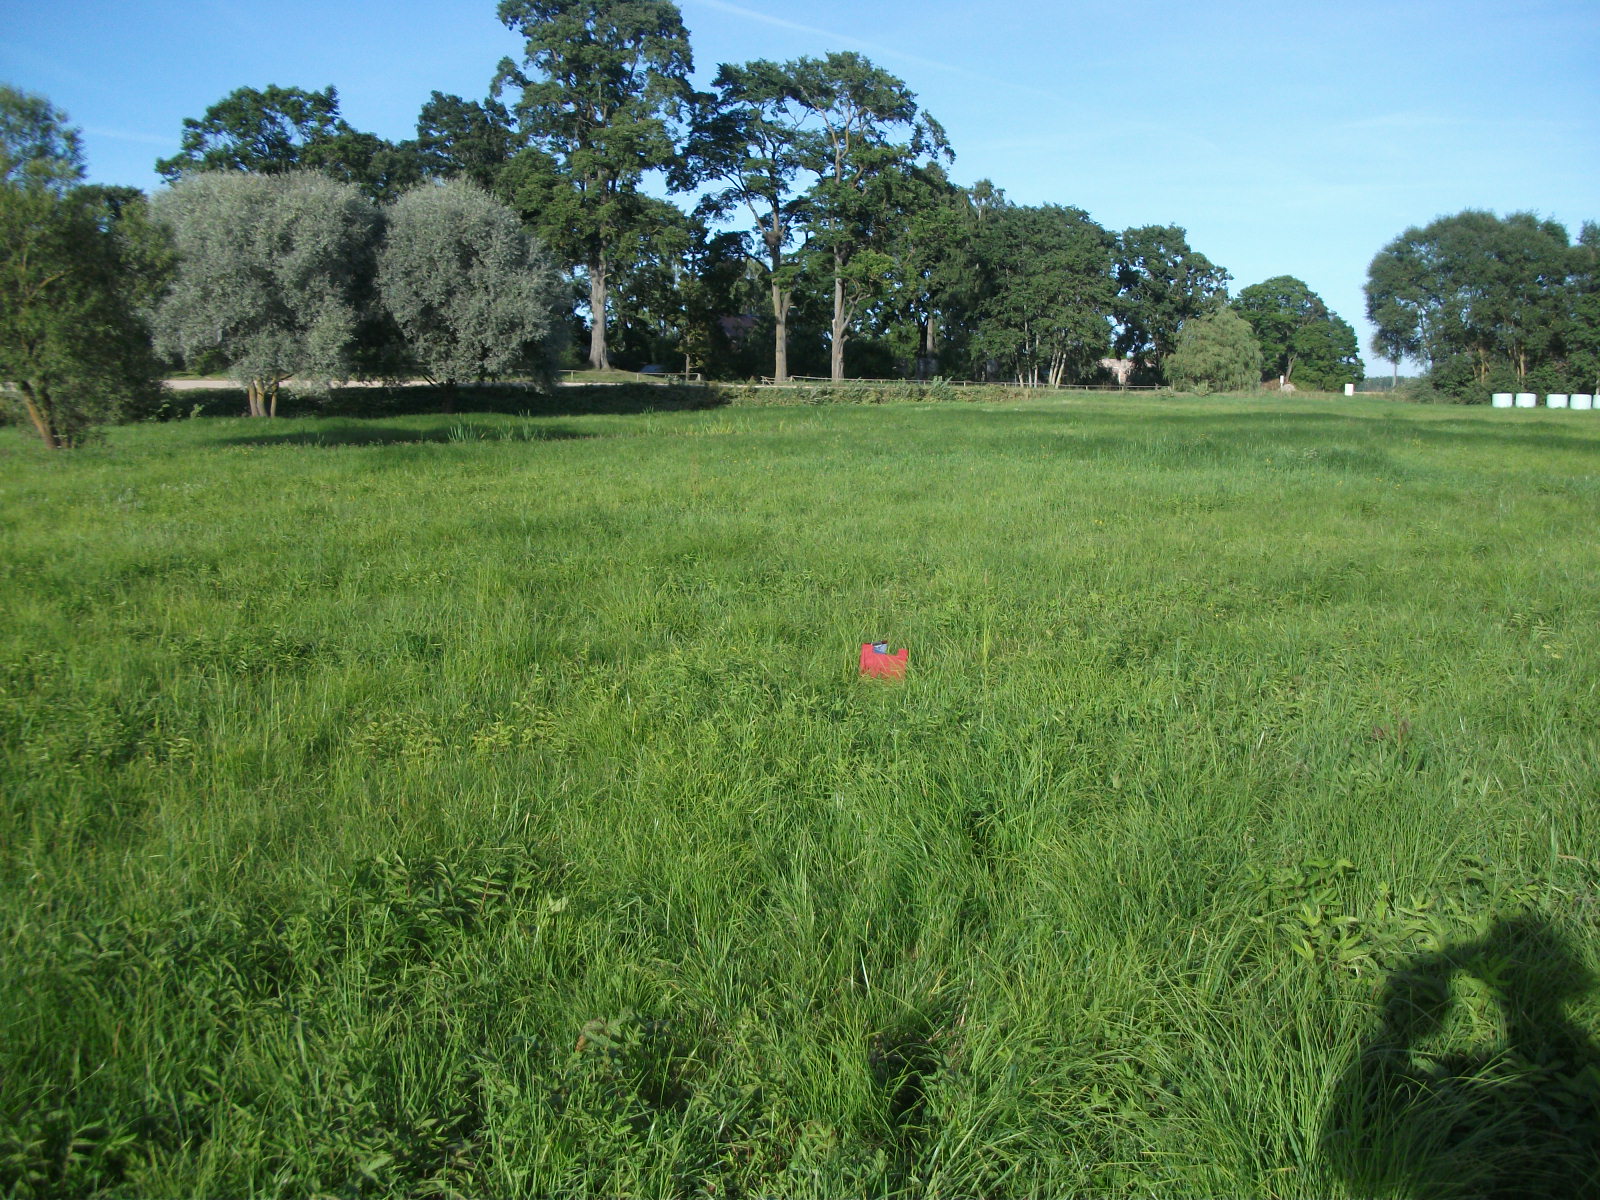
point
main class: Grassland
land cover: Grassland without tree/shrub cover
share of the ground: > 75 %
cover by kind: herbaceous plants 100 %
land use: Agriculture (excluding fallow land and kitchen gardens)
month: August
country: LV
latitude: 56.3774
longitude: 26.2200
